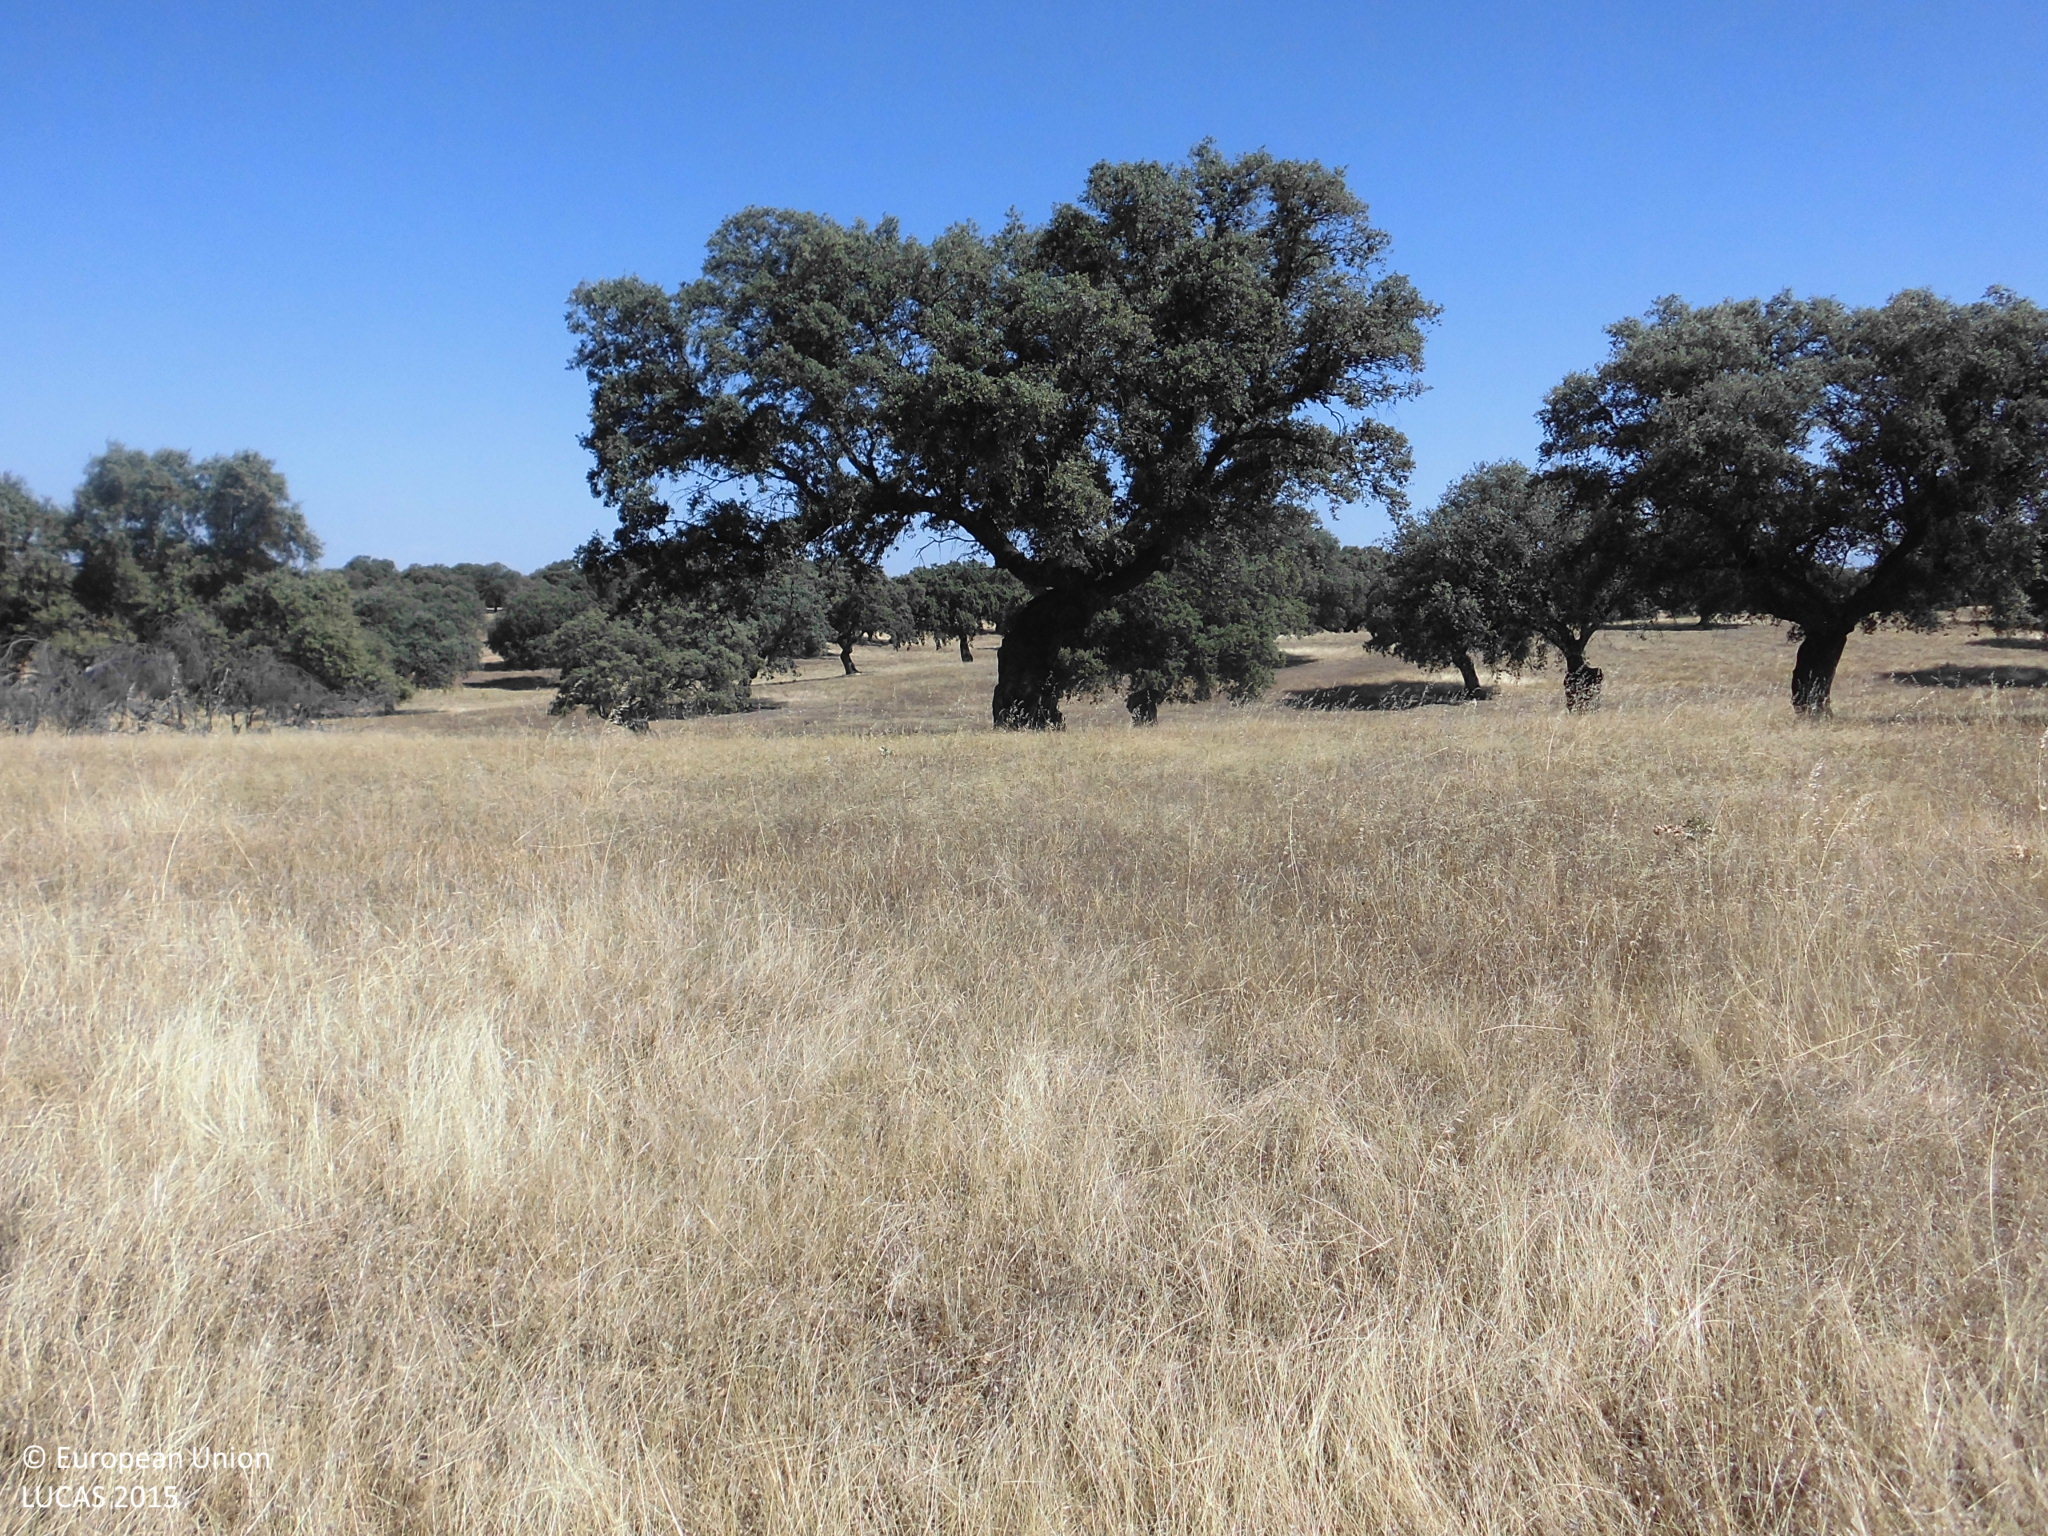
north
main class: Woodland
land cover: Broadleaved woodland
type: broadleaved evergreen forest
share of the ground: 10 - 25 %
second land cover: Grassland without tree/shrub cover
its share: > 75 %
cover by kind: herbaceous plants 75 %, broadleaved forest trees 25 %
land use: Forestry
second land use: Agriculture (excluding fallow land and kitchen gardens)
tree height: > 5 m
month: July
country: ES
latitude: 39.8455
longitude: -5.7816
